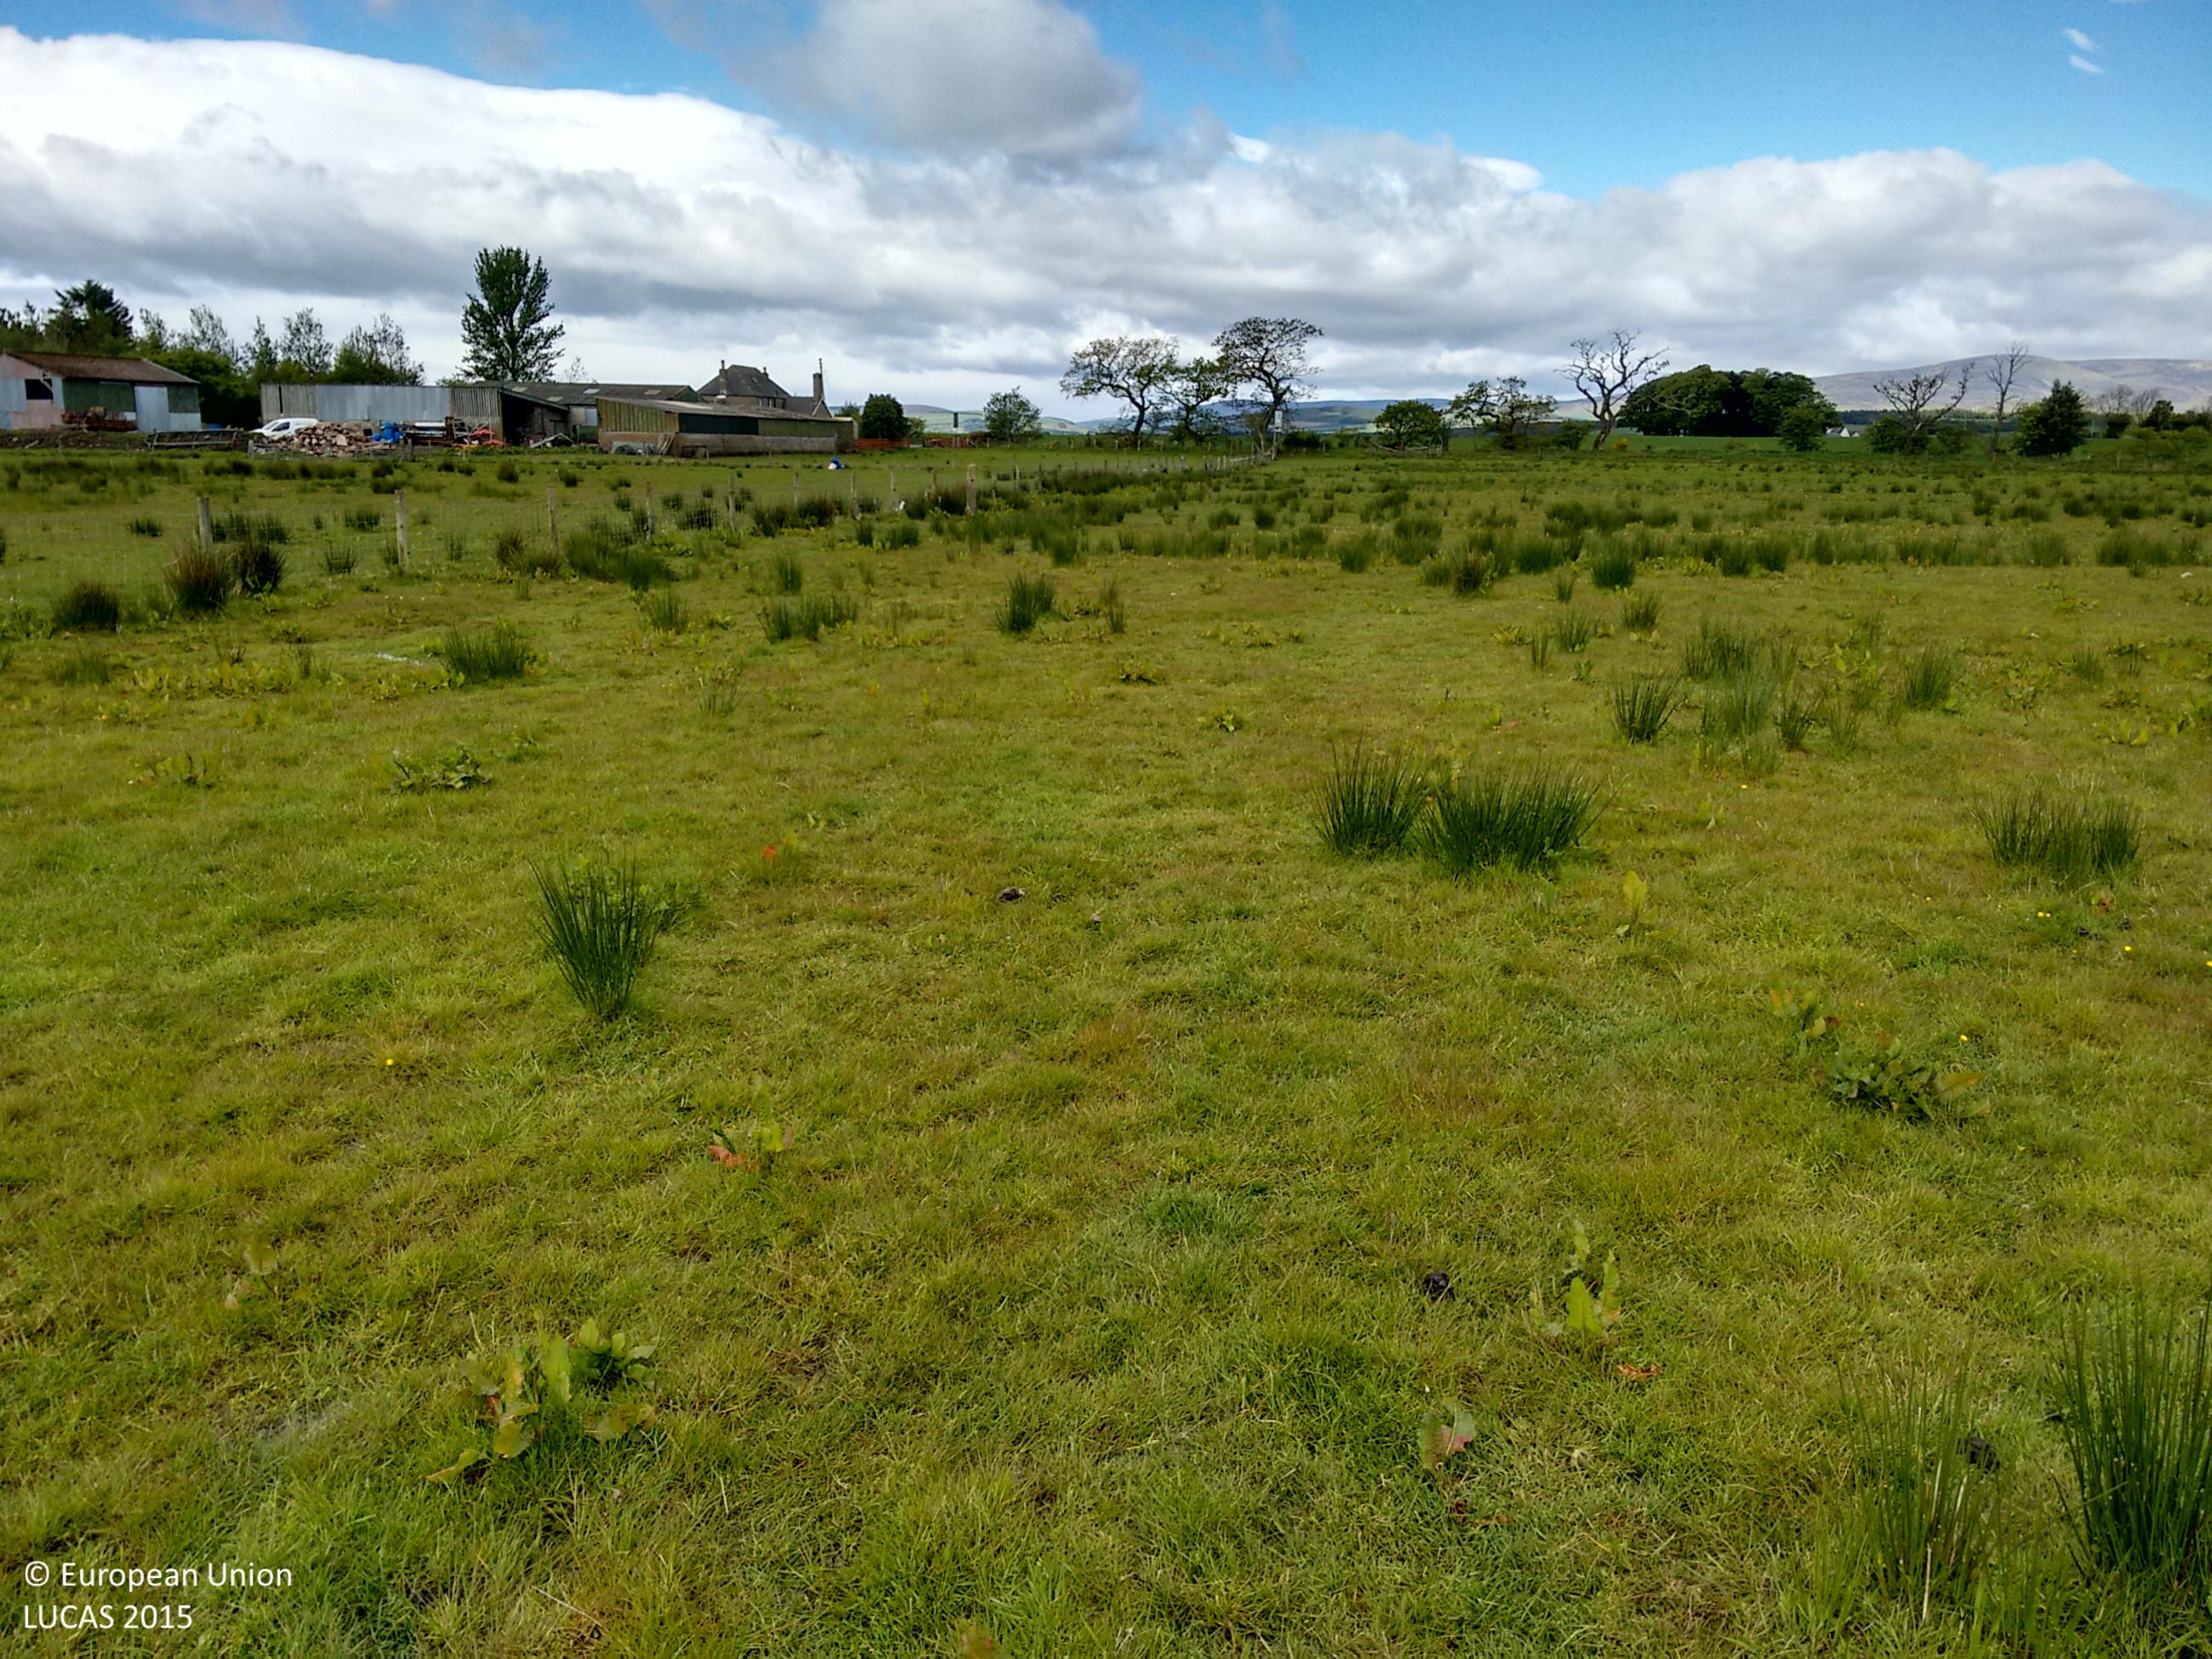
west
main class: Grassland
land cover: Grassland without tree/shrub cover
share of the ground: > 75 %
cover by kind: herbaceous plants 100 %
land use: Agriculture (excluding fallow land and kitchen gardens)
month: June
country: GB
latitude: 56.8428
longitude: -2.5652
